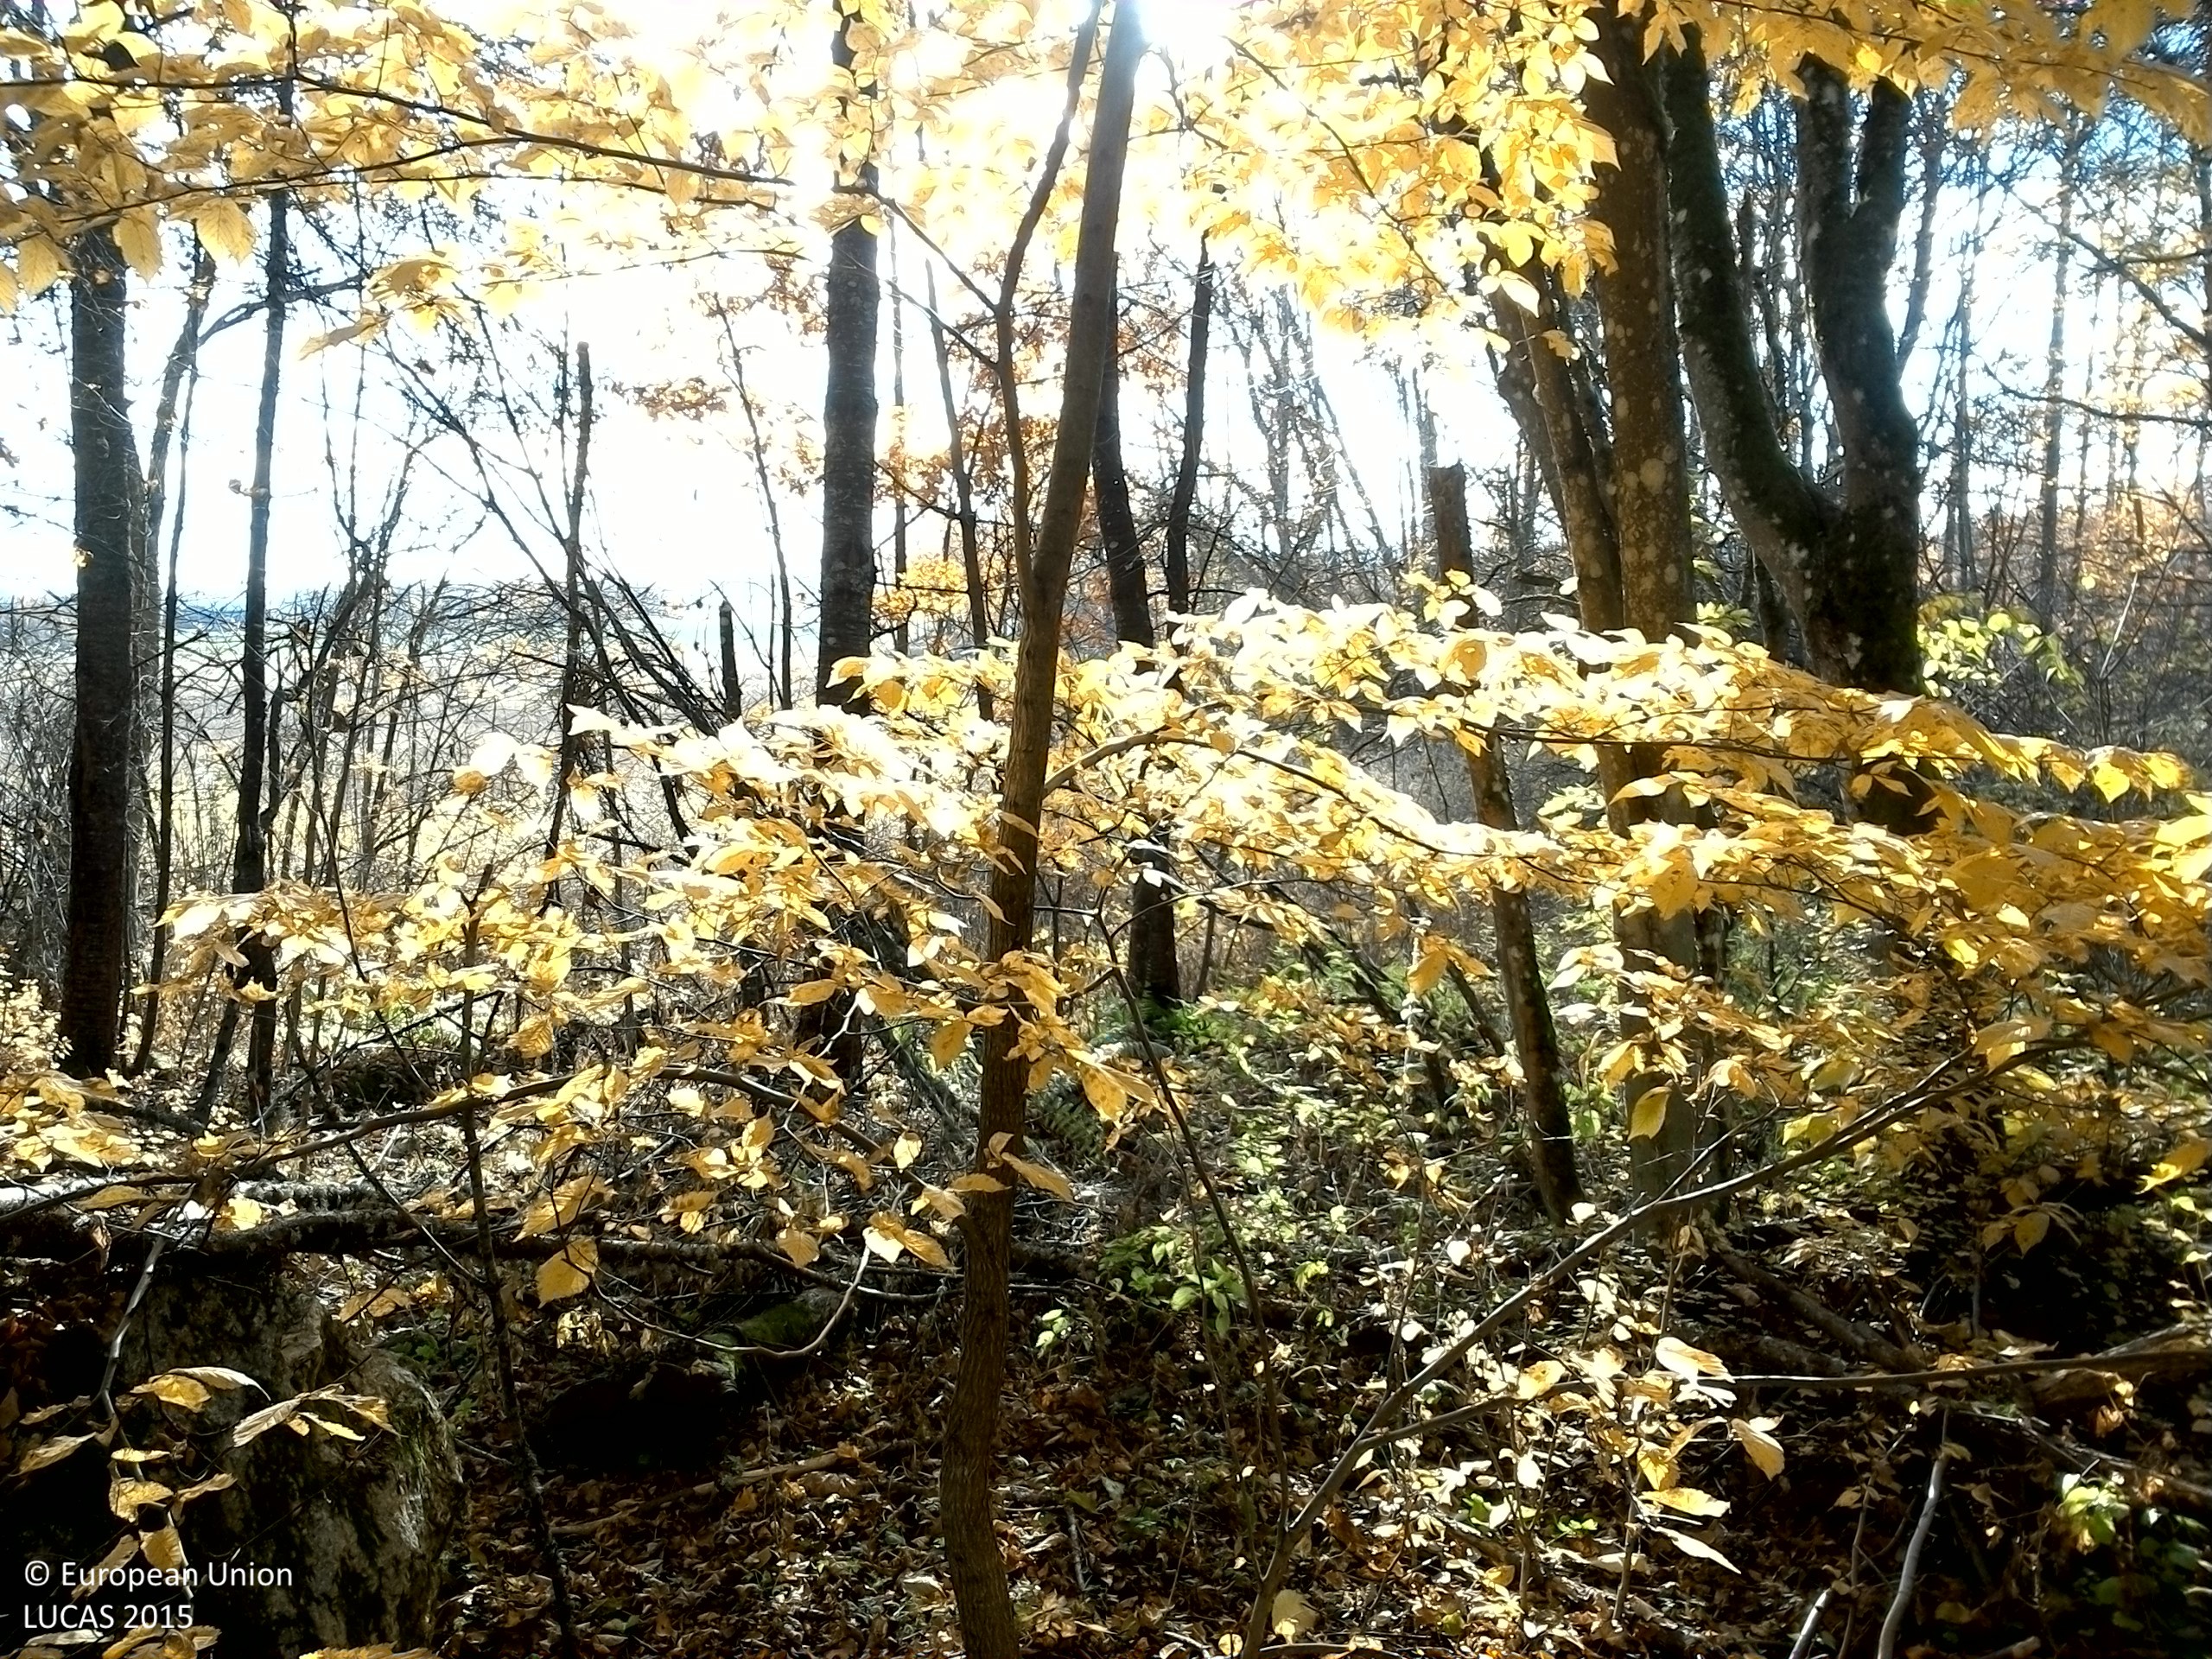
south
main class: Woodland
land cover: Broadleaved woodland
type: hemiboreal forest and nemoral coniferous forest and mixed broadleaved-coniferous forest
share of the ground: > 75 %
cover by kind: broadleaved forest trees 75 %, shrubs 10 %, herbaceous plants 10 %, consolidated bare surface 5 %
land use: Forestry
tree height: > 5 m
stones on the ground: < 10 %
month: October
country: SE
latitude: 59.4428
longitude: 16.3231
